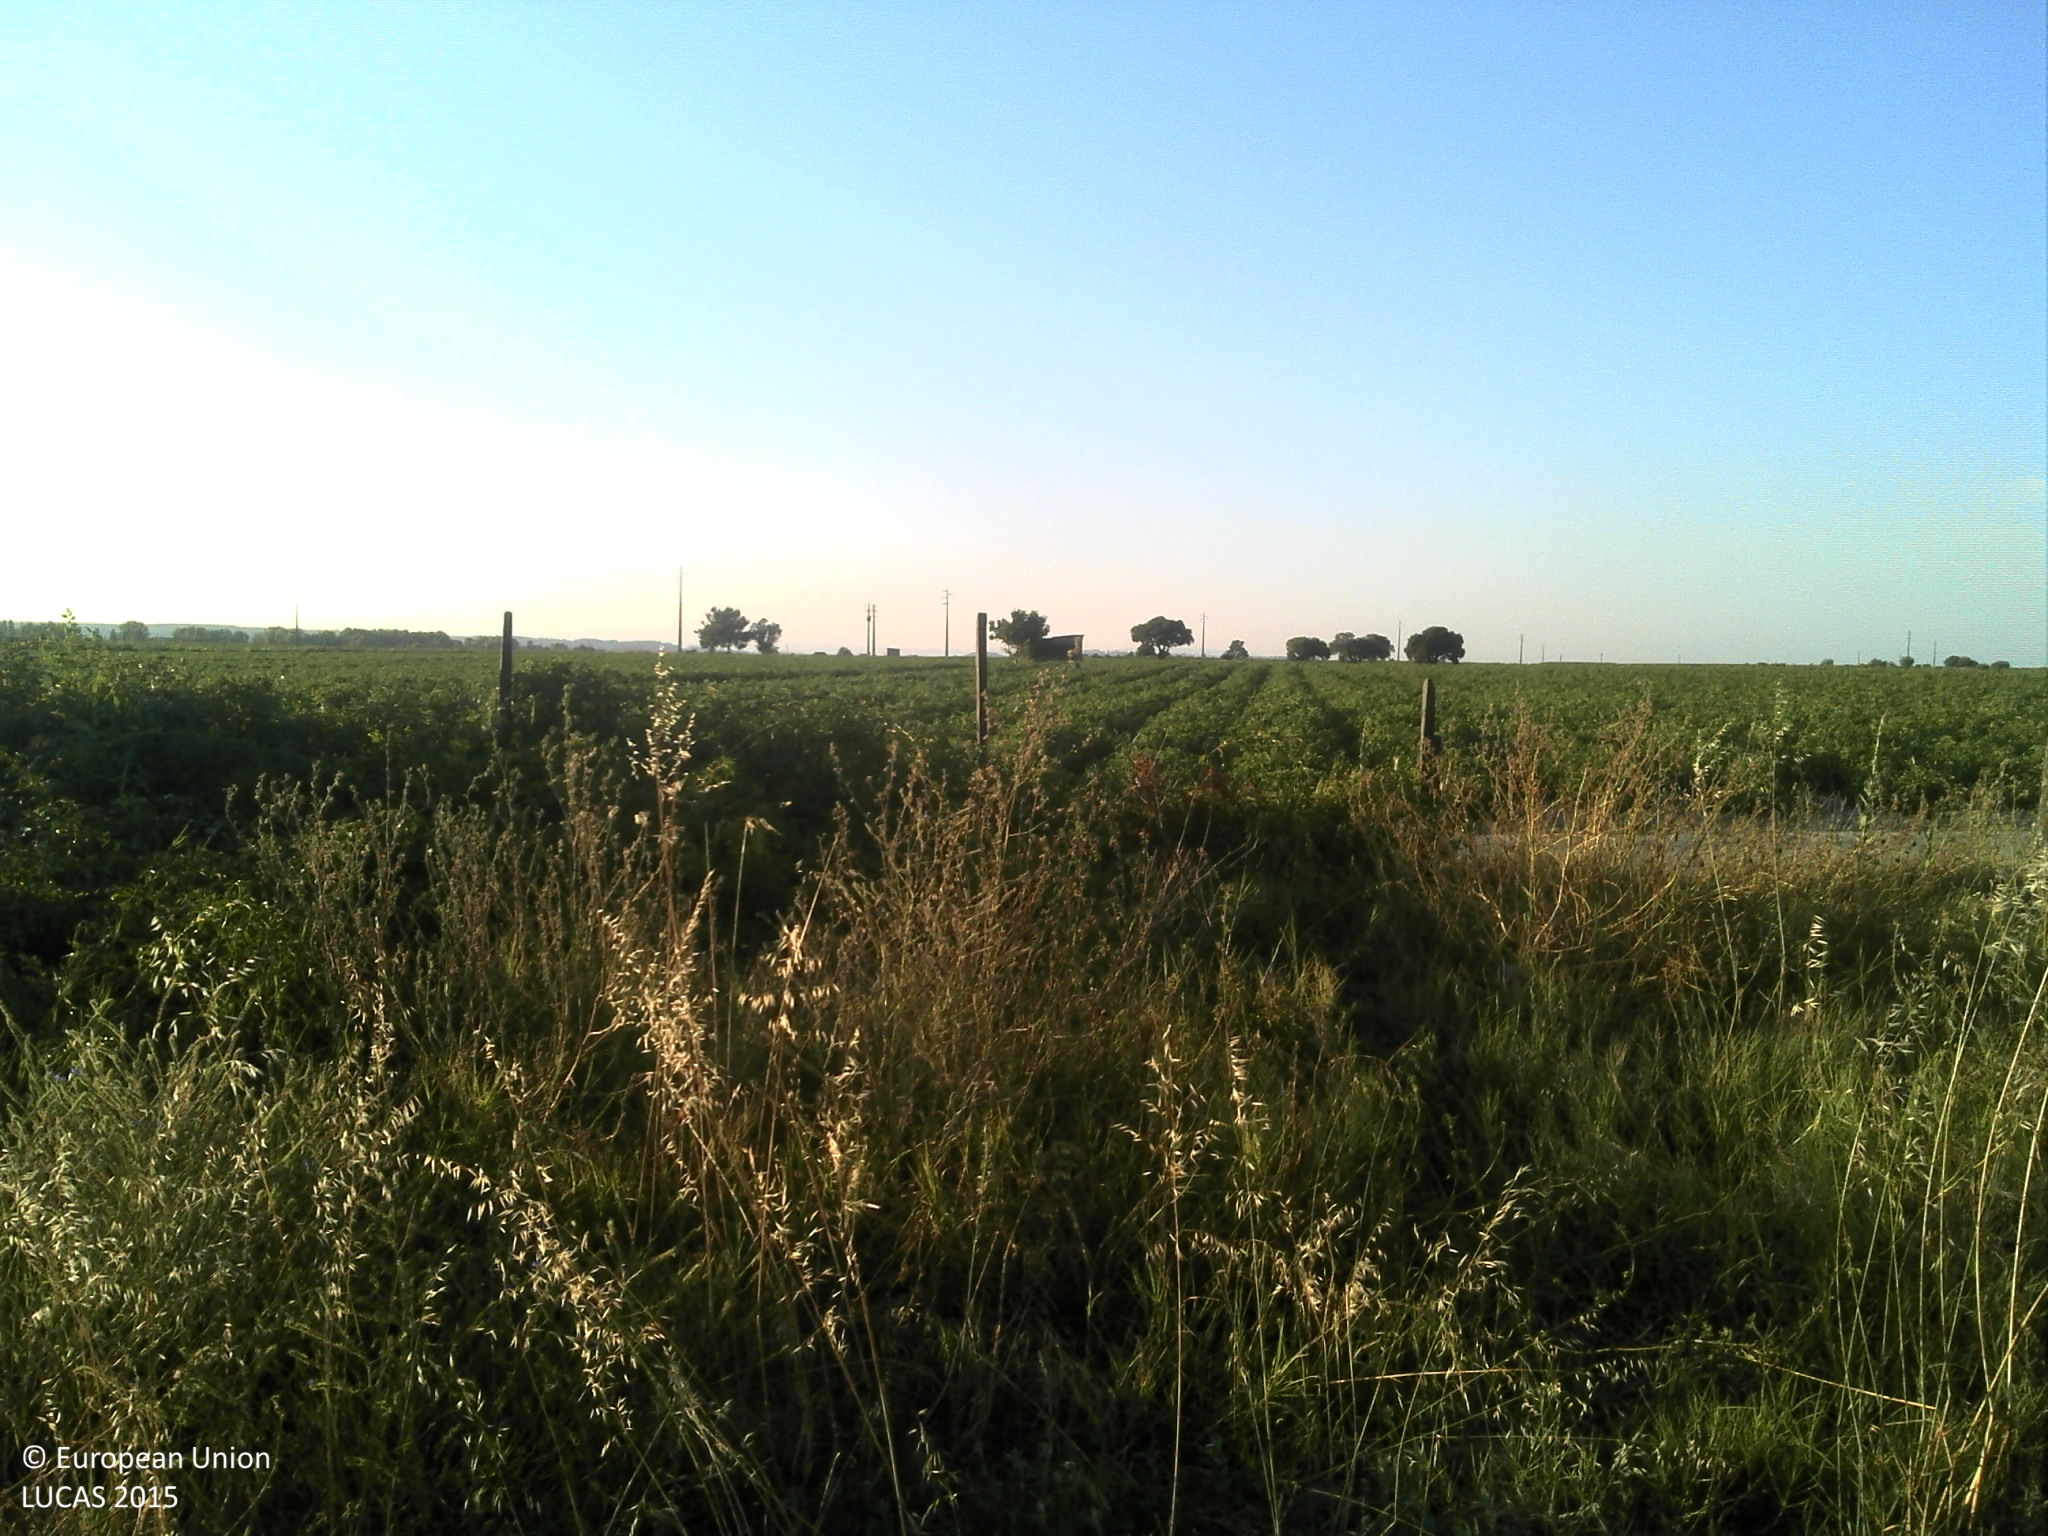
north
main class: Cropland
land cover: Vineyards
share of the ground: 25 - 50 %
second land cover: Grassland without tree/shrub cover
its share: 50 - 75 %
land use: Agriculture (excluding fallow land and kitchen gardens)
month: June
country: PT
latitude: 39.1170
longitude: -8.7032
